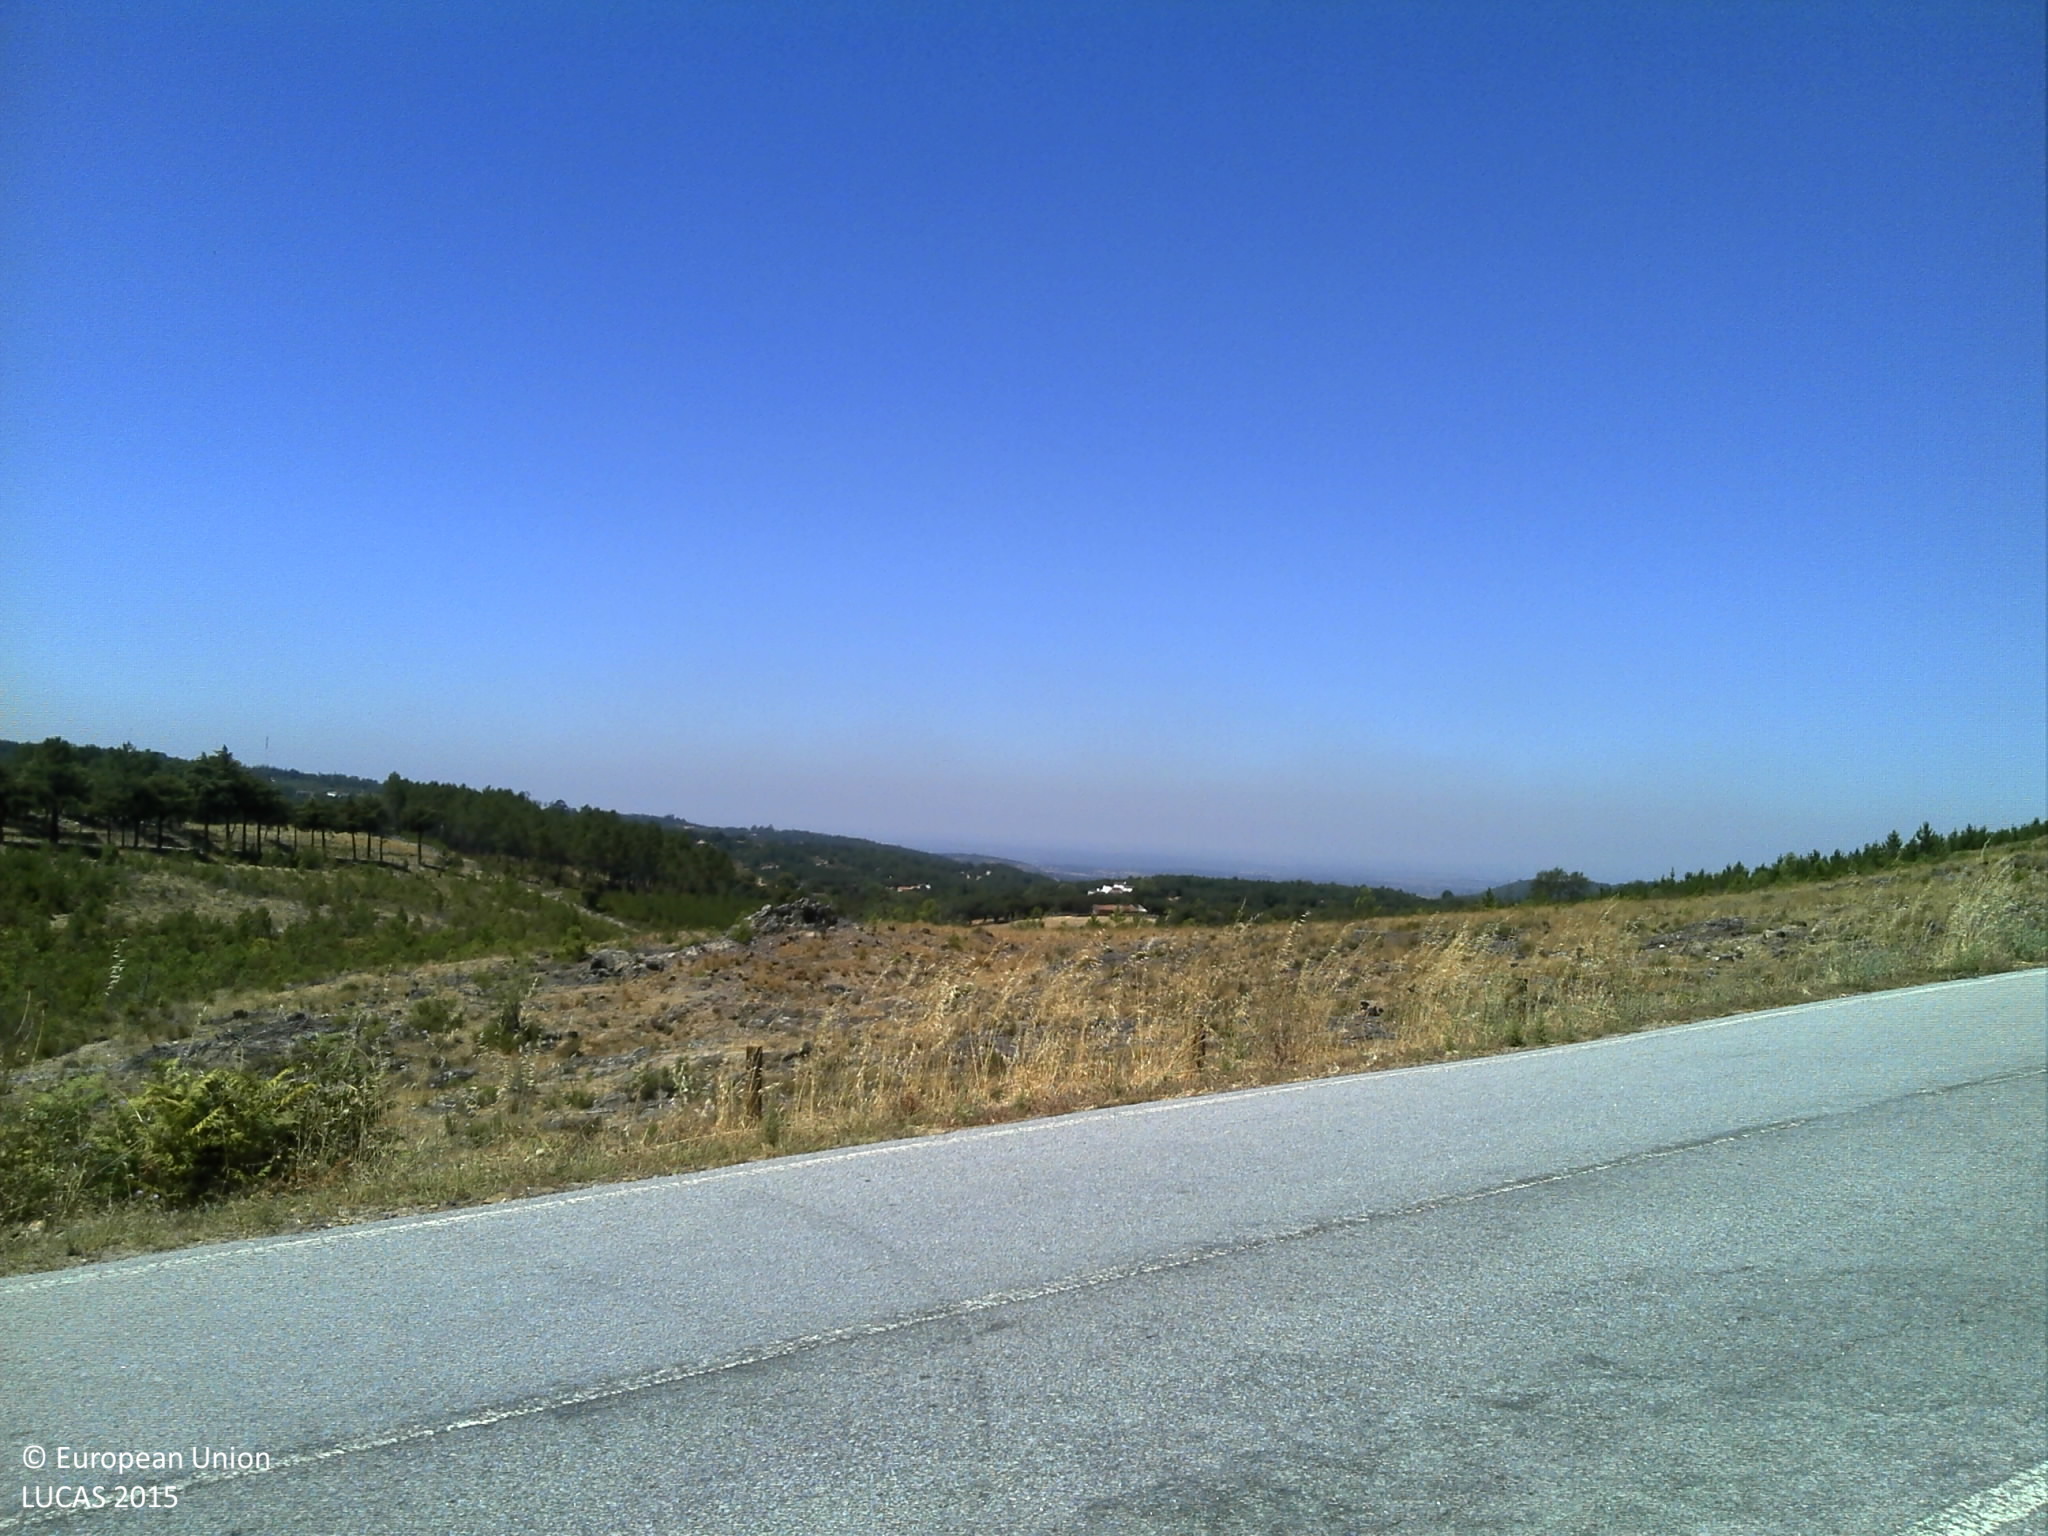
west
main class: Woodland
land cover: Pine dominated coniferous woodland
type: coniferous forest of the mediterranean region
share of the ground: 10 - 25 %
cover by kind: shrubs 85 %, coniferous forest trees 15 %
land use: Forestry
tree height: > 5 m
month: August
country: PT
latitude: 39.3119
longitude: -7.3792
